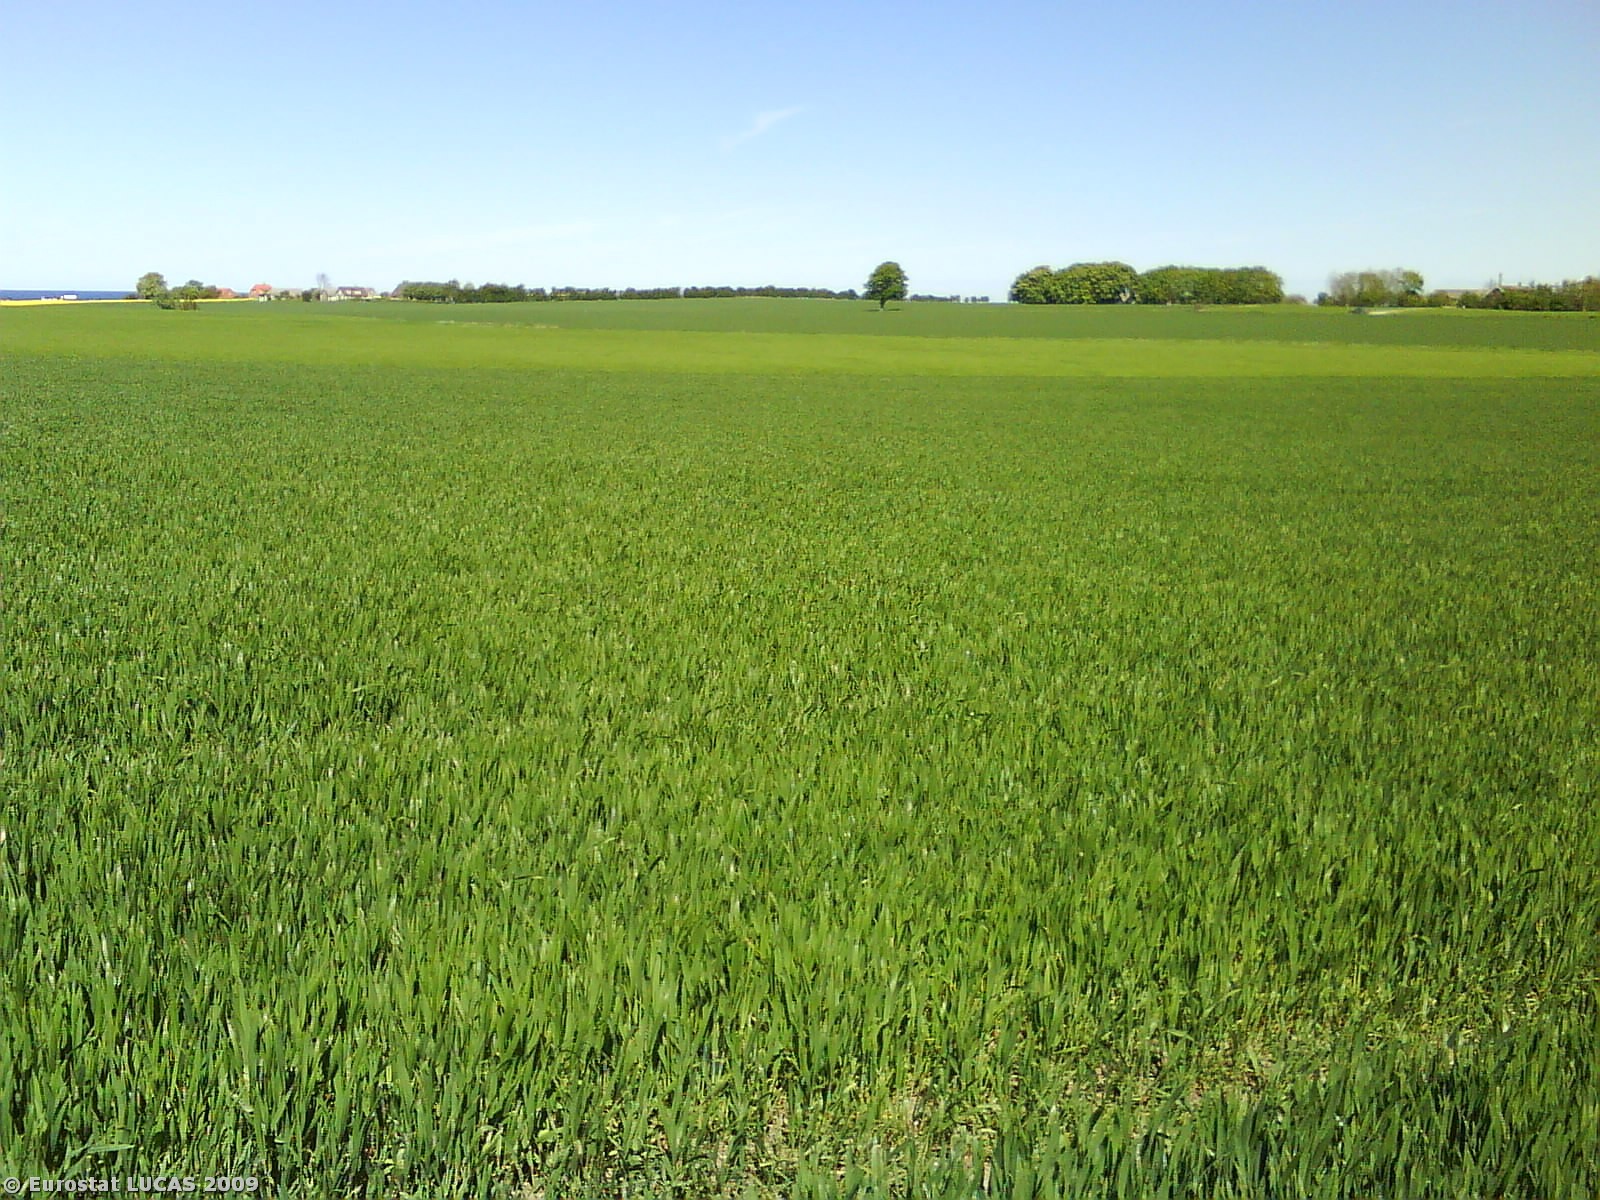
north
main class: Cropland
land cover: Common wheat
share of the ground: > 75 %
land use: Agriculture (excluding fallow land and kitchen gardens)
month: May
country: DK
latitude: 56.4723
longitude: 10.8917
